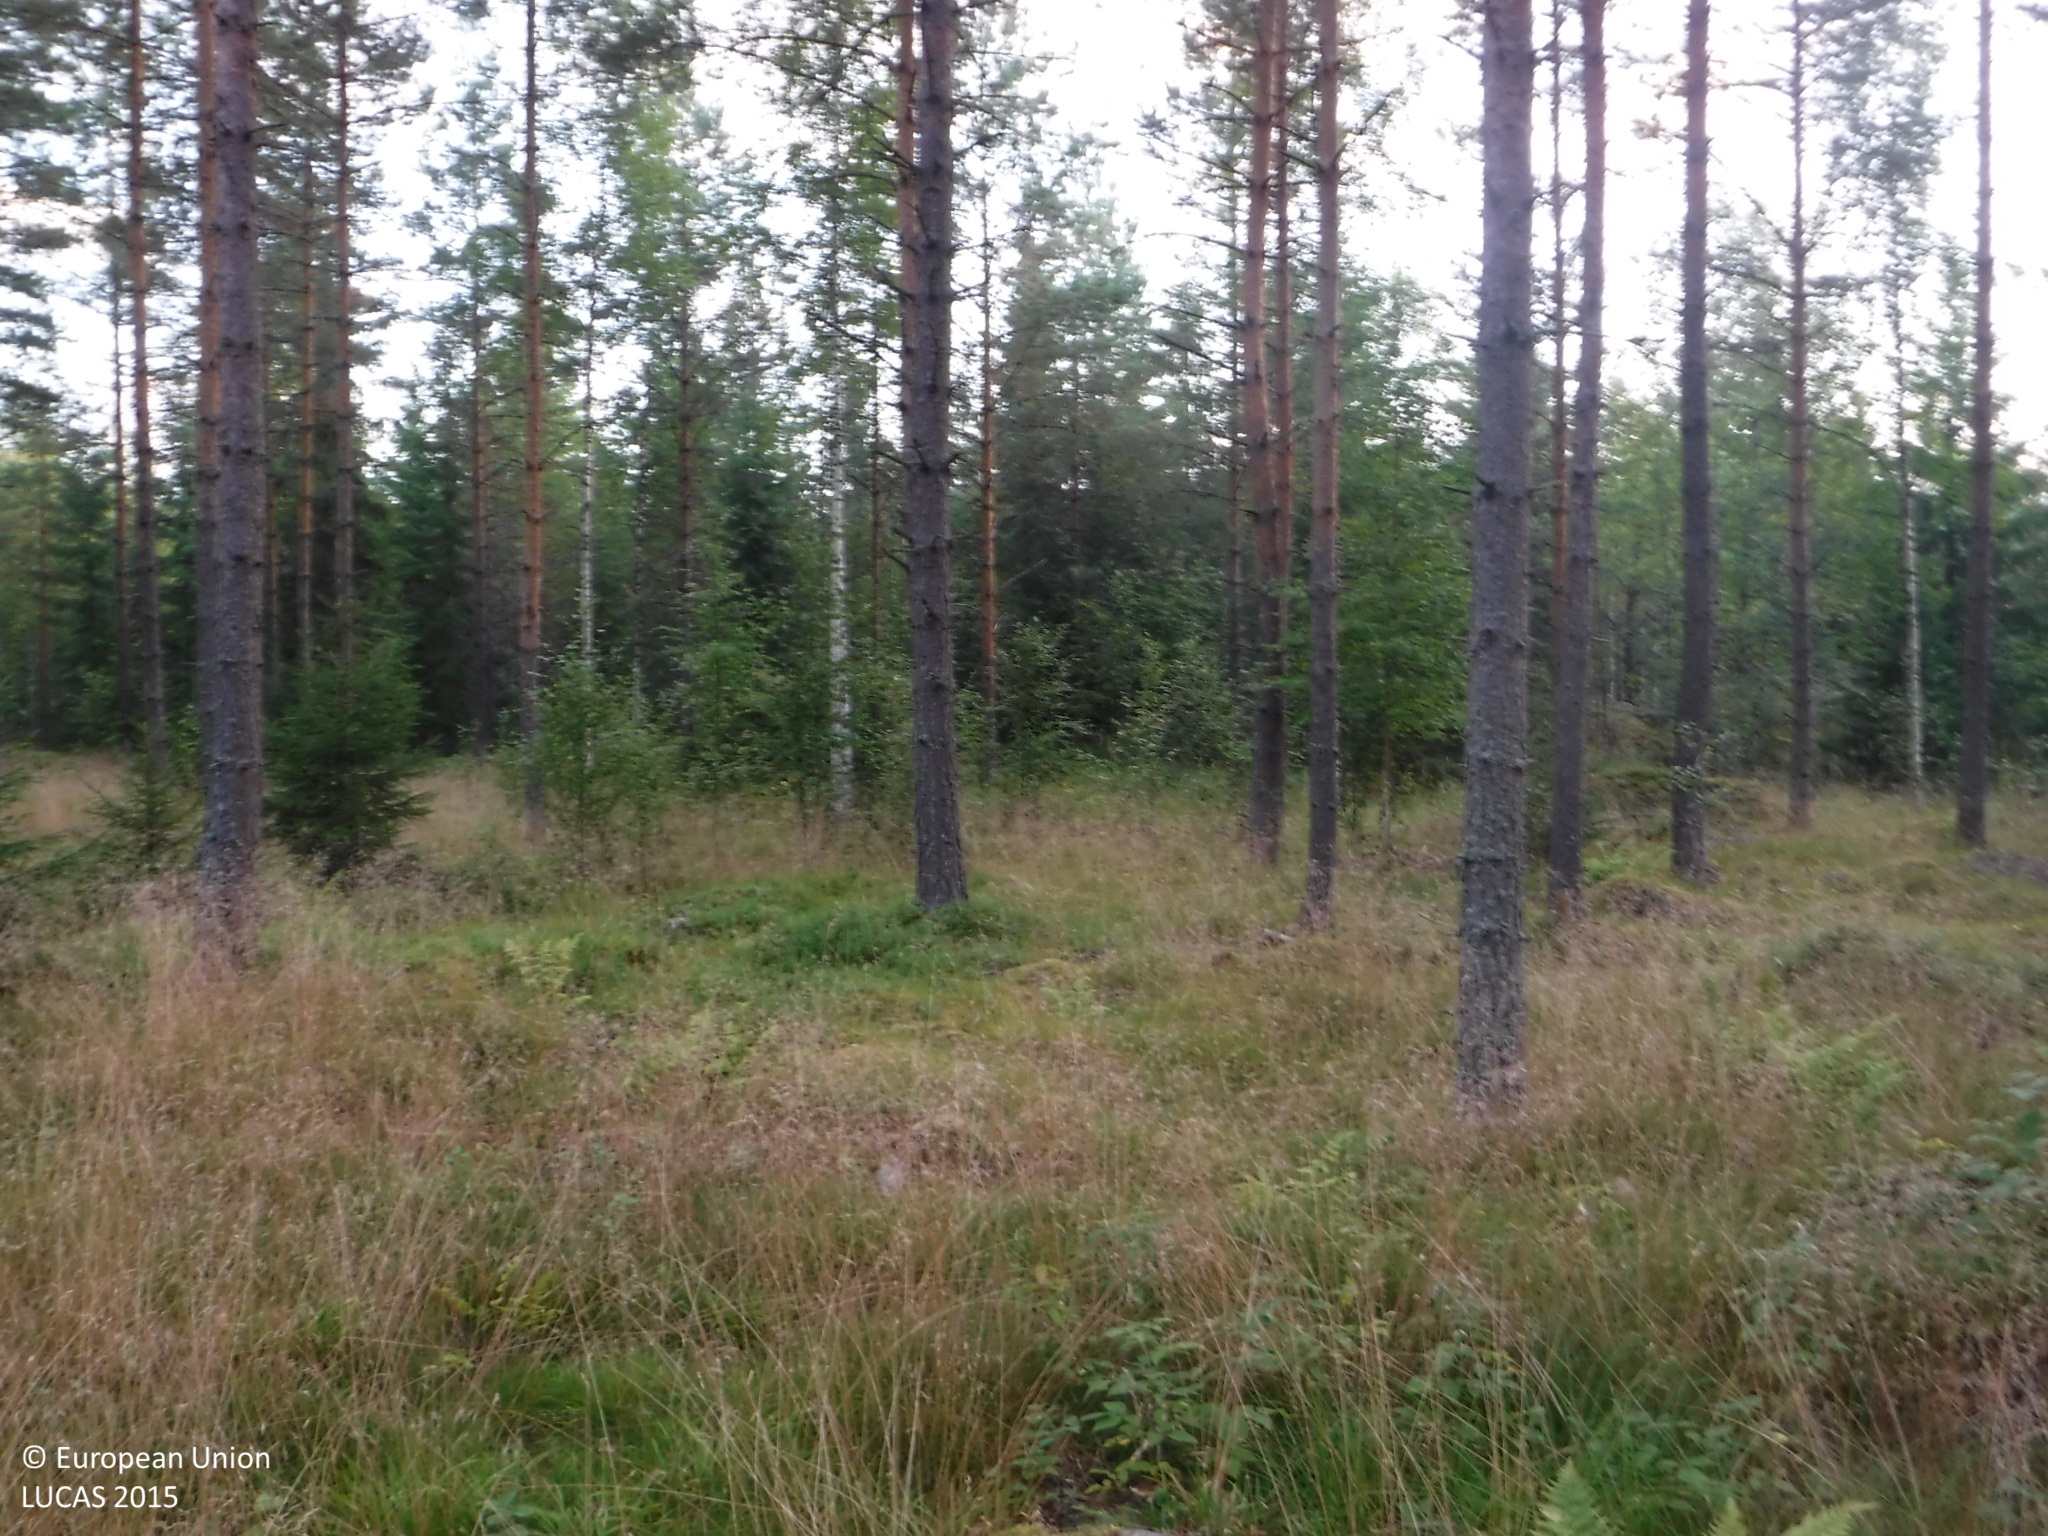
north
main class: Woodland
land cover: Pine dominated coniferous woodland
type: boreal forest
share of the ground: 50 - 75 %
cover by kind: coniferous forest trees 50 %, herbaceous plants 25 %, lichens and mosses 20 %, shrubs 5 %
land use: Forestry
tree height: > 5 m
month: August
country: FI
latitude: 61.1081
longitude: 23.0438
